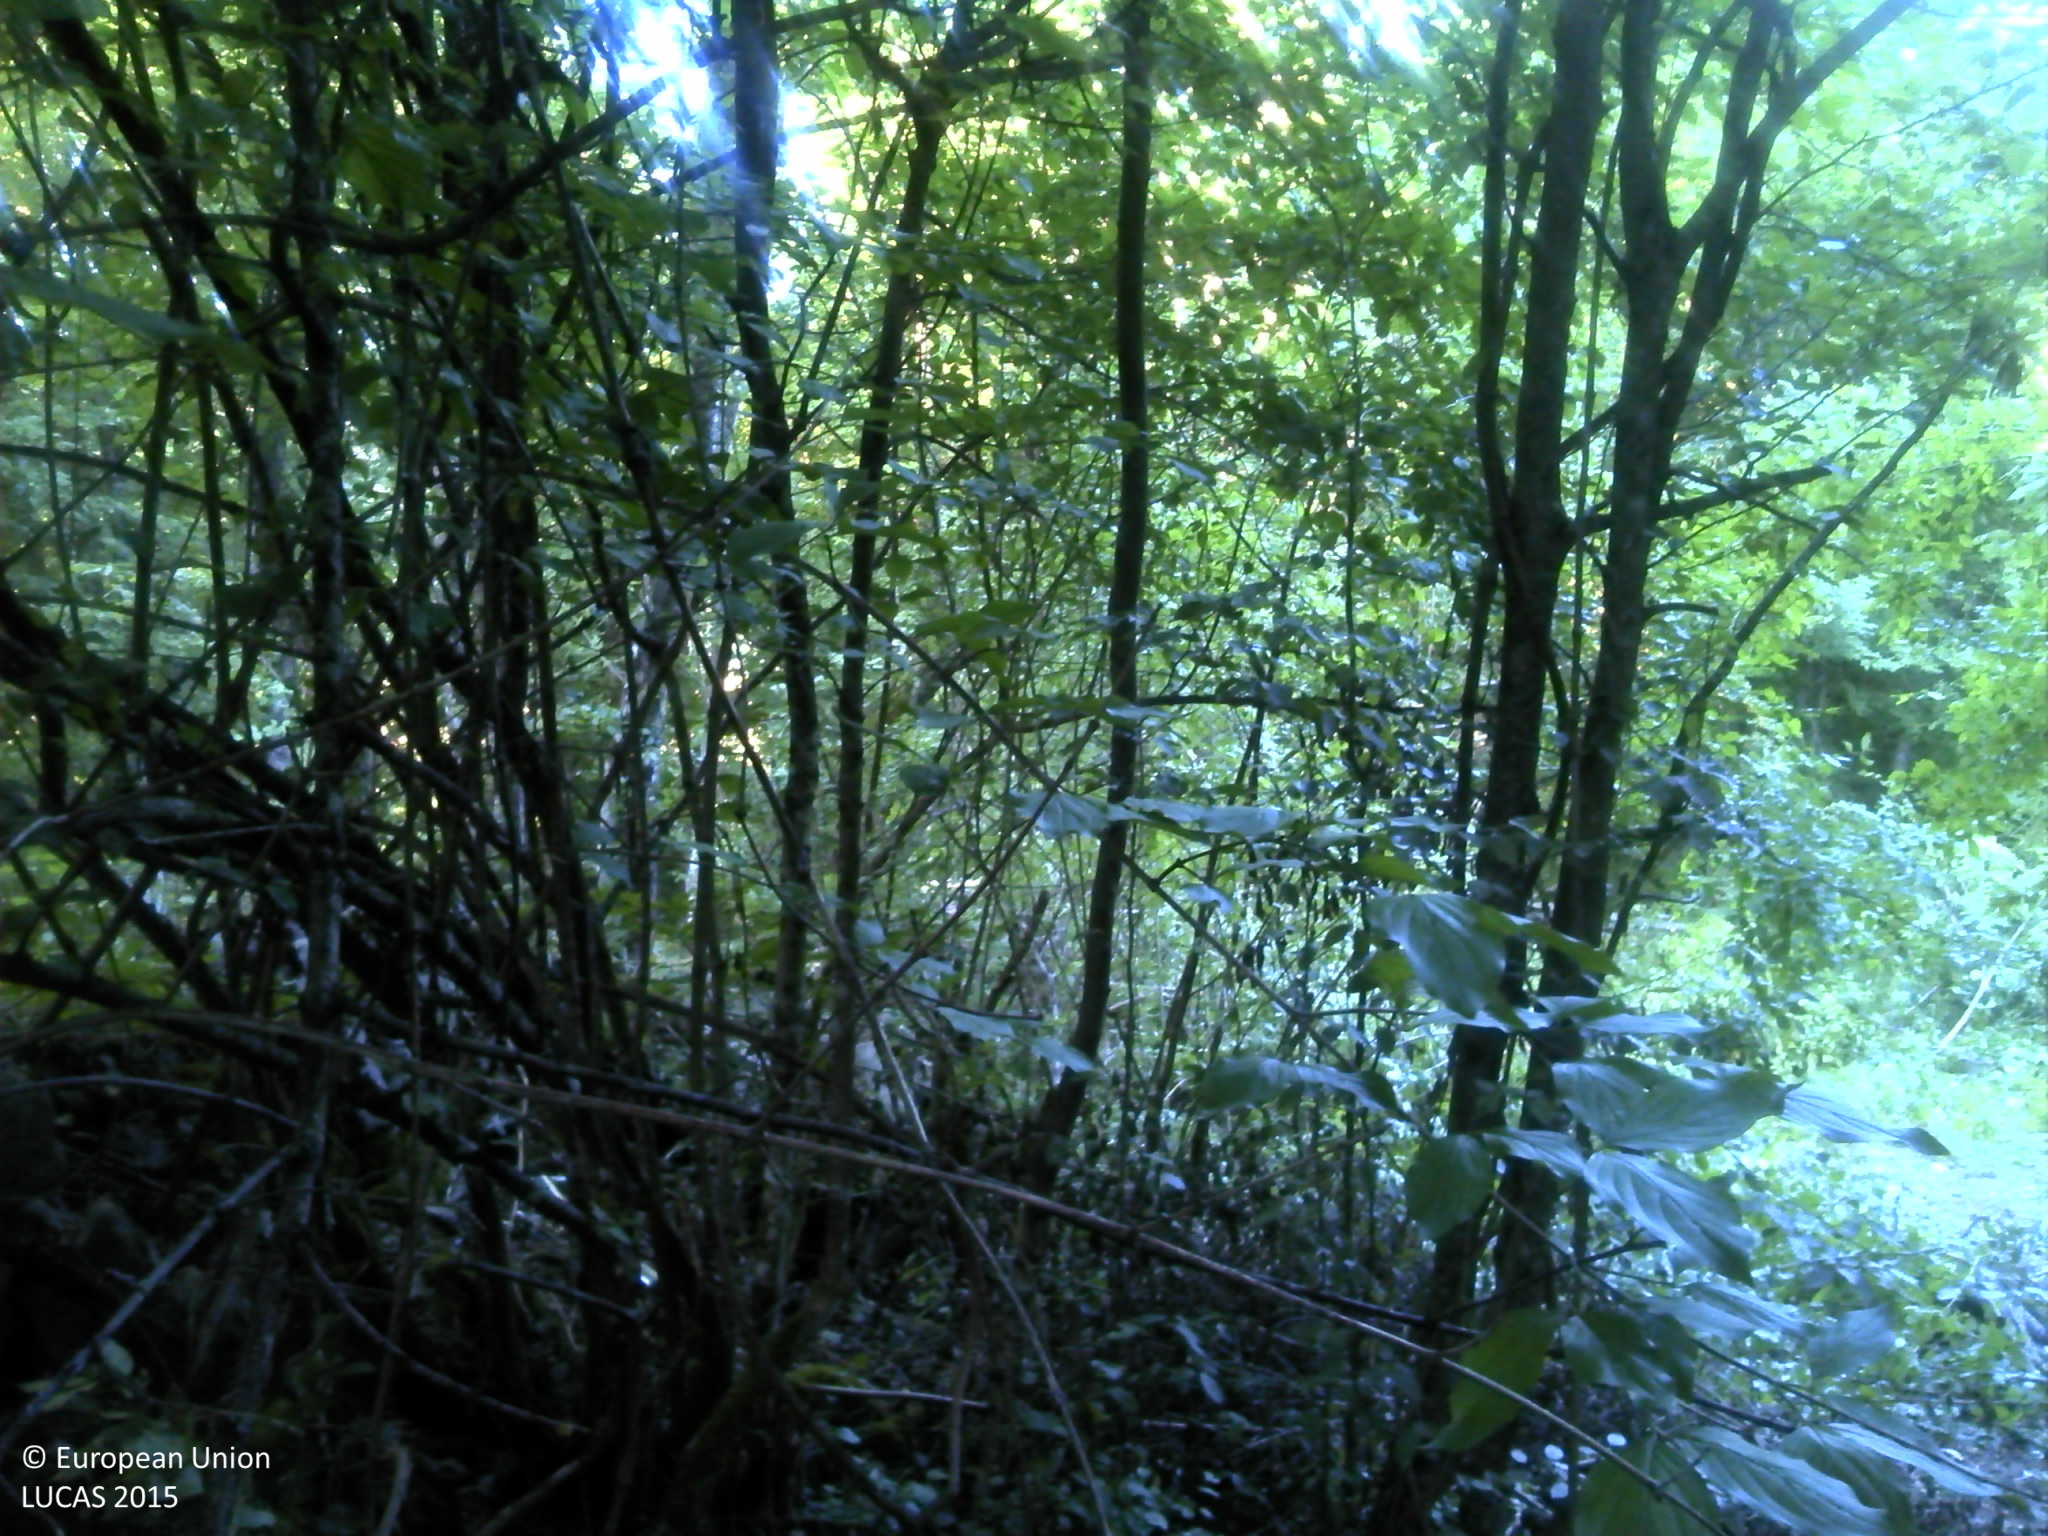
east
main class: Woodland
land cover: Broadleaved woodland
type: beech forest
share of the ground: > 75 %
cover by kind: broadleaved forest trees 90 %, shrubs 10 %
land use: Semi-natural and natural areas not in use
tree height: > 5 m
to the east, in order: Broadleaved woodland; Artificial constructions in urban areas; Grassland without tree/shrub cover; Electric lines; Shrubland with sparse tree cover; Electric lines; Grassland with sparse tree/shrub cover; Grassland without tree/shrub cover
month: July
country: HR
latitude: 45.0313
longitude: 15.2368
